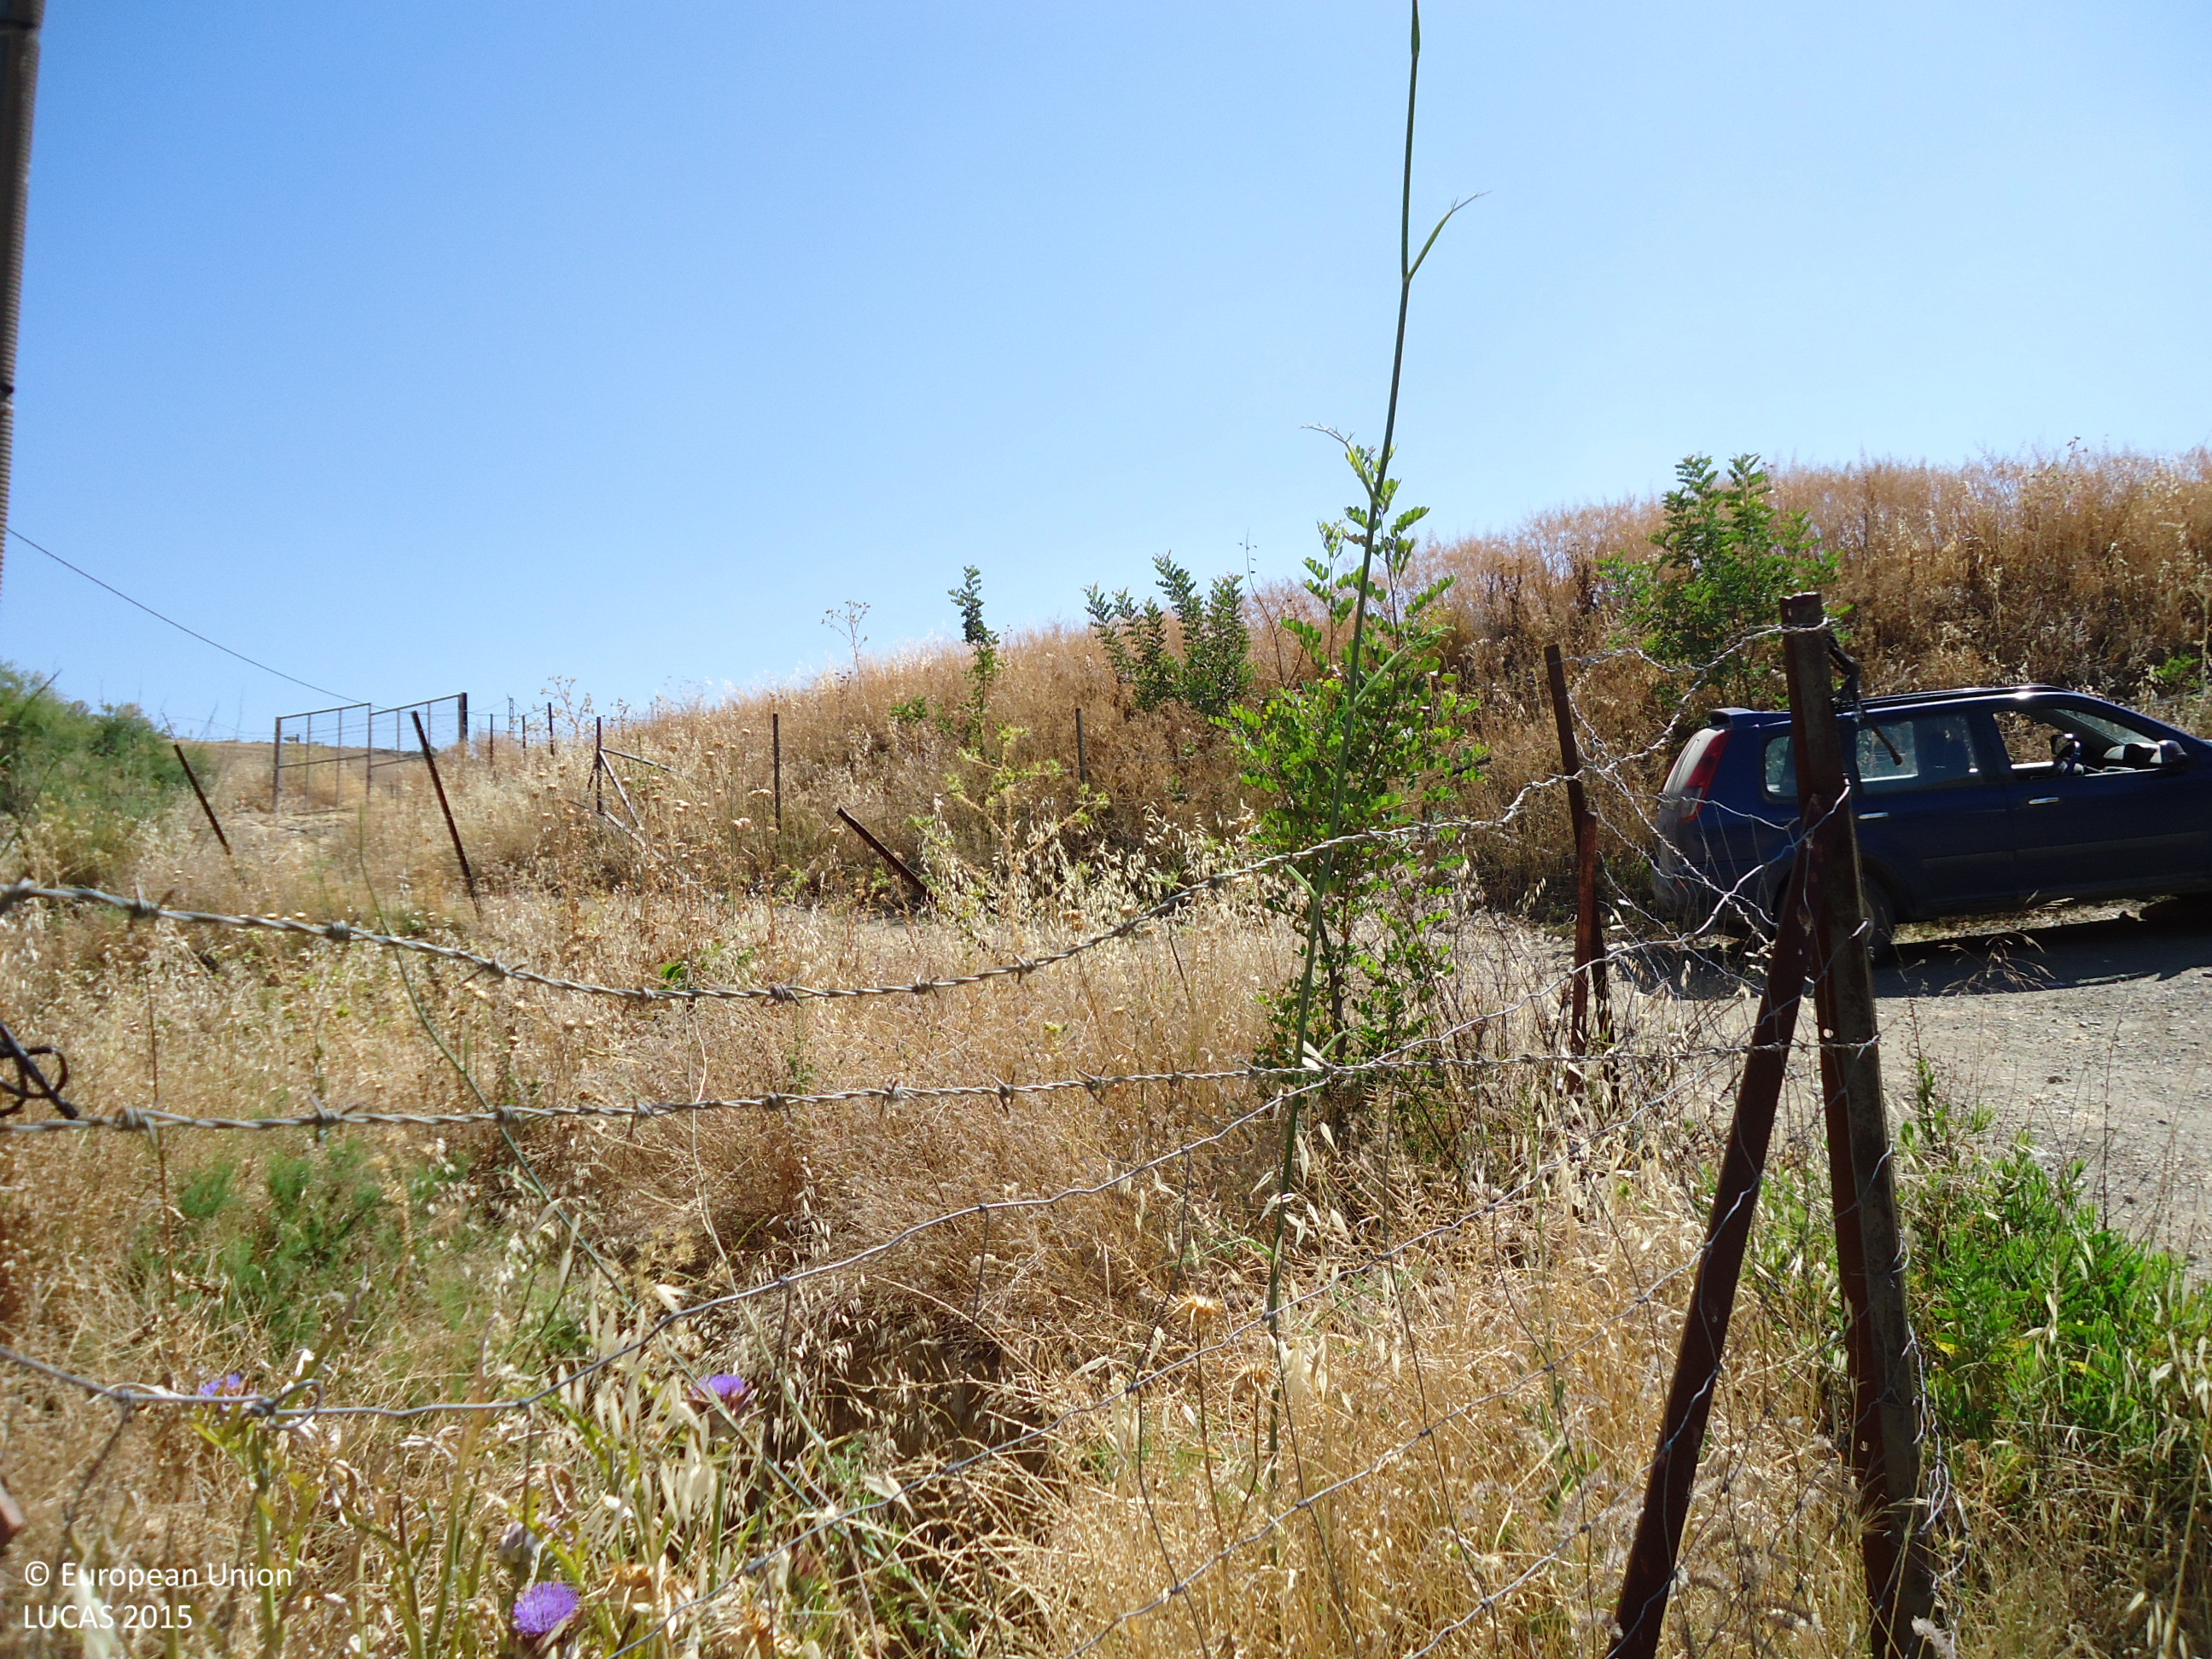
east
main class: Grassland
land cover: Grassland without tree/shrub cover
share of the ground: > 75 %
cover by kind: herbaceous plants 100 %
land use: Agriculture (excluding fallow land and kitchen gardens)
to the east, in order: Grassland without tree/shrub cover; Tracks; Grassland without tree/shrub cover; Artificial constructions in urban areas; Grassland without tree/shrub cover
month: June
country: ES
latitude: 36.8244
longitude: -4.7836
